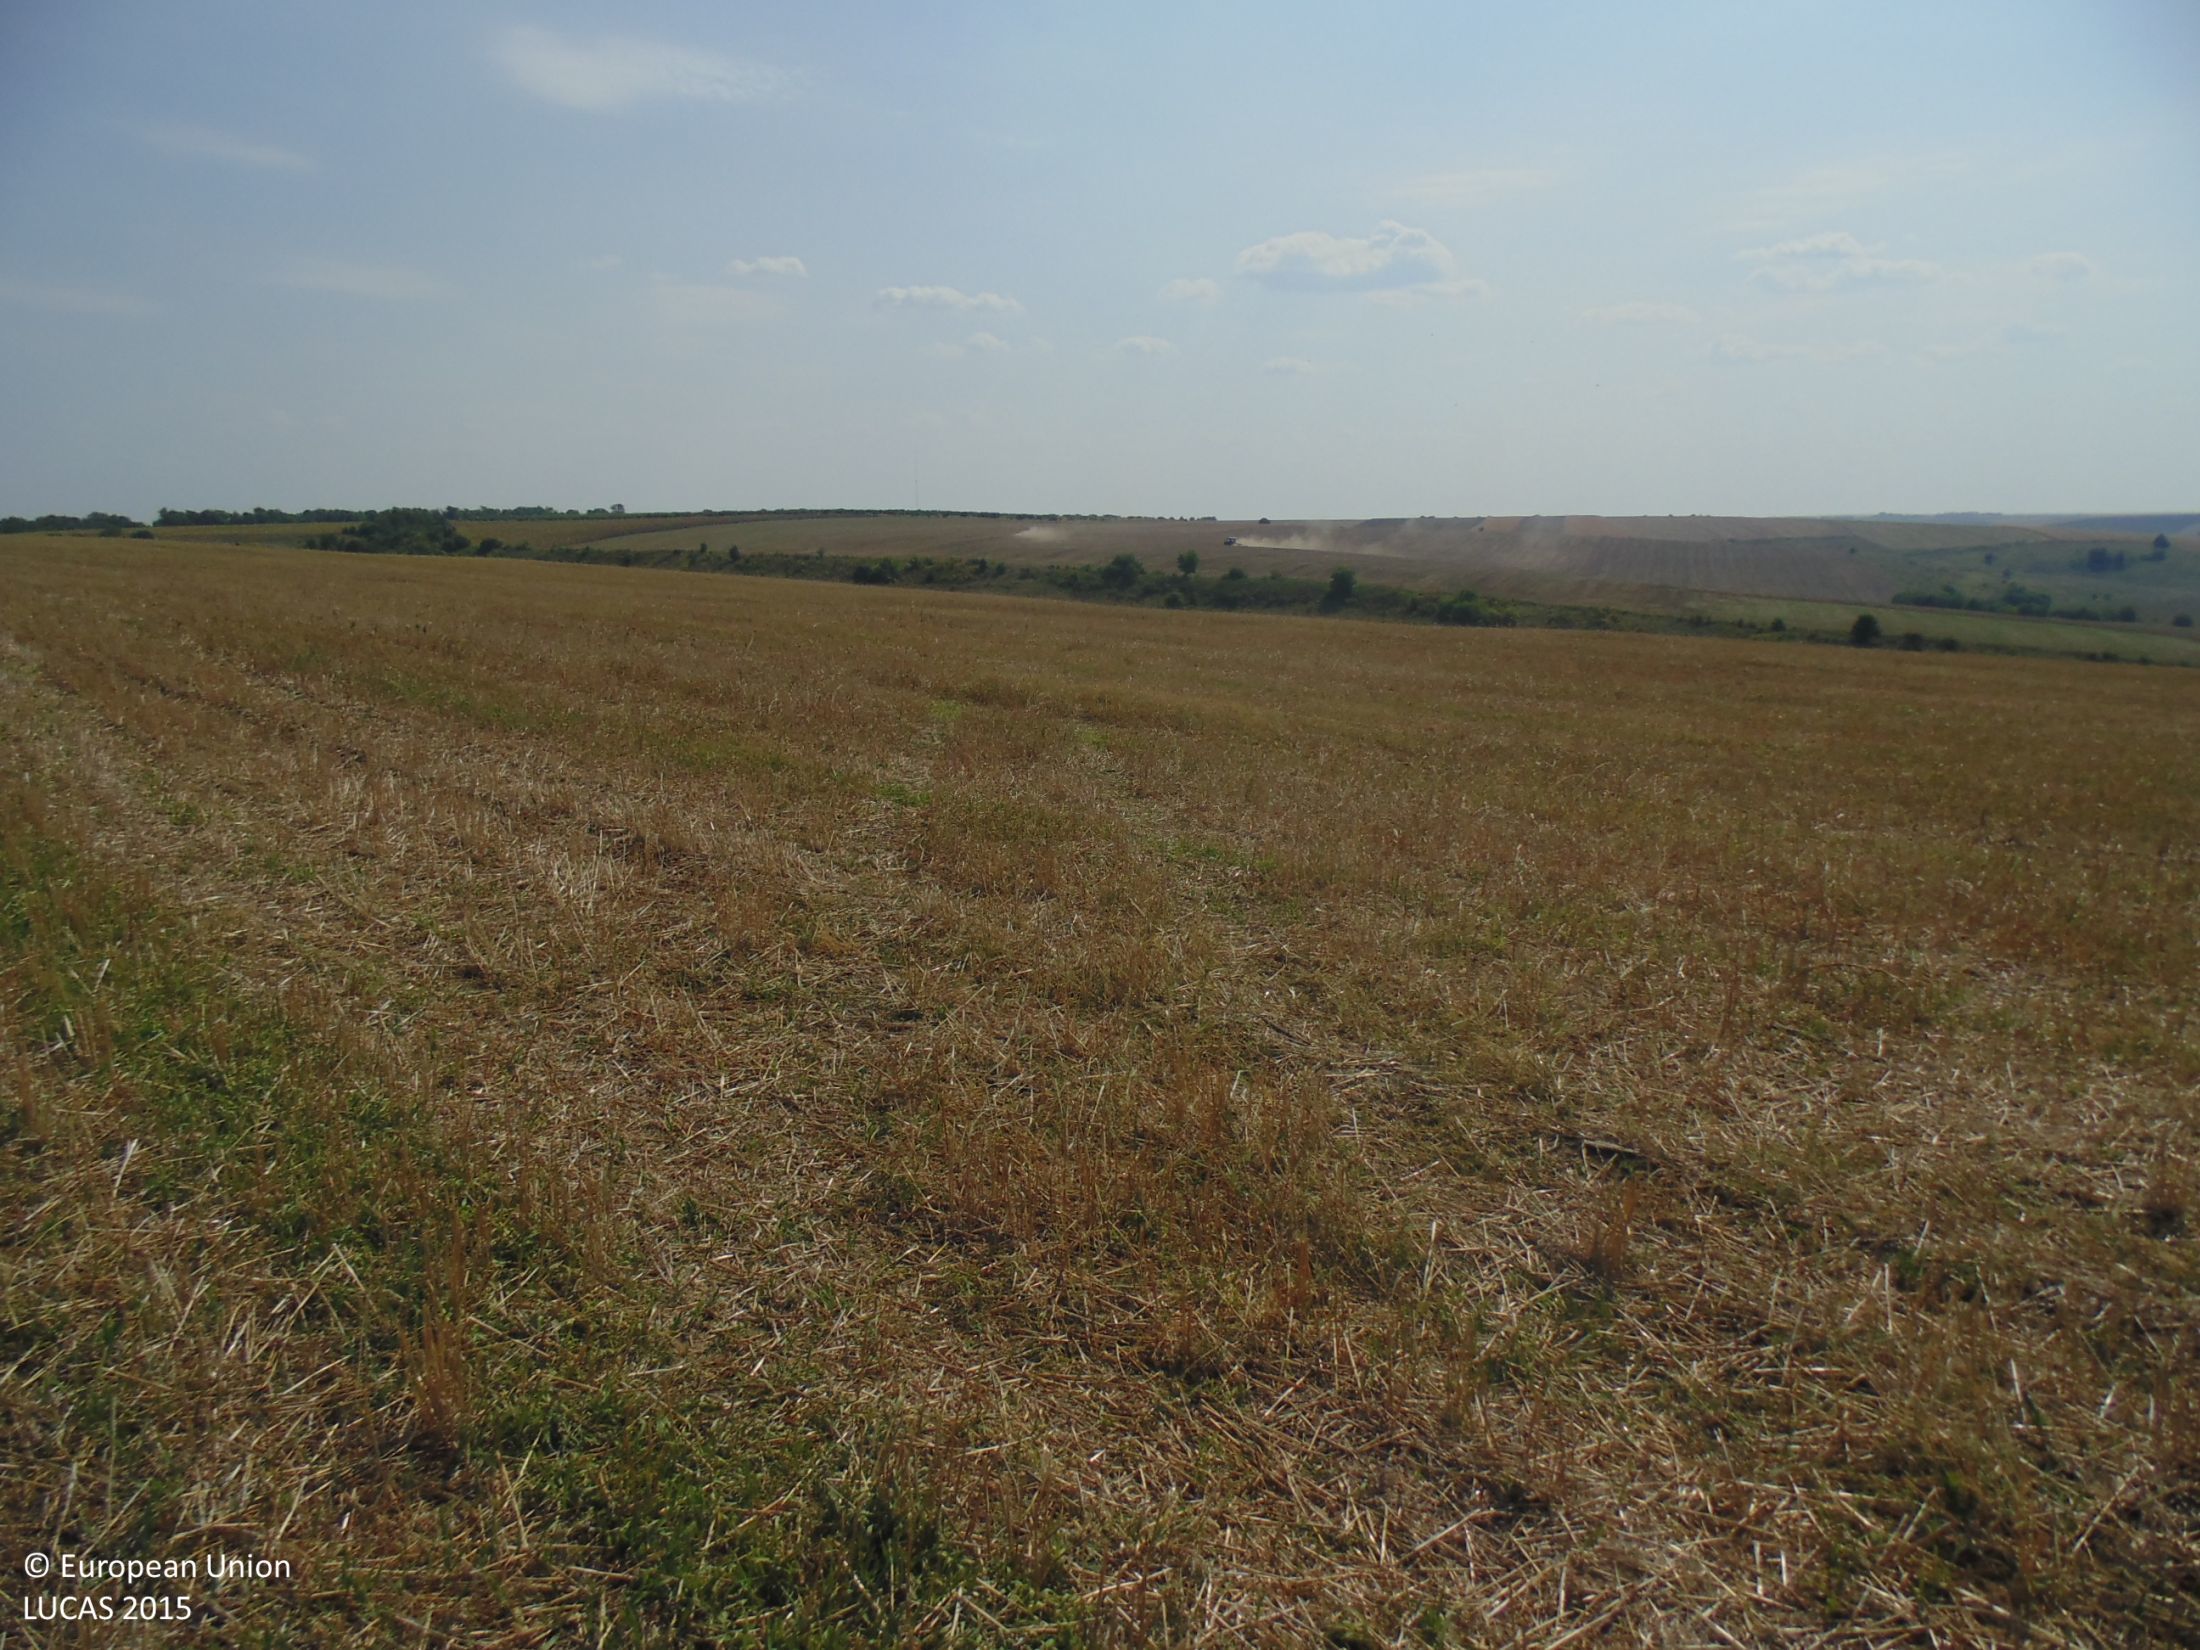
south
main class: Cropland
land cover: Barley
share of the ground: 25 - 50 %
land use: Agriculture (excluding fallow land and kitchen gardens)
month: August
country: BG
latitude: 43.9887
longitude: 27.3005
